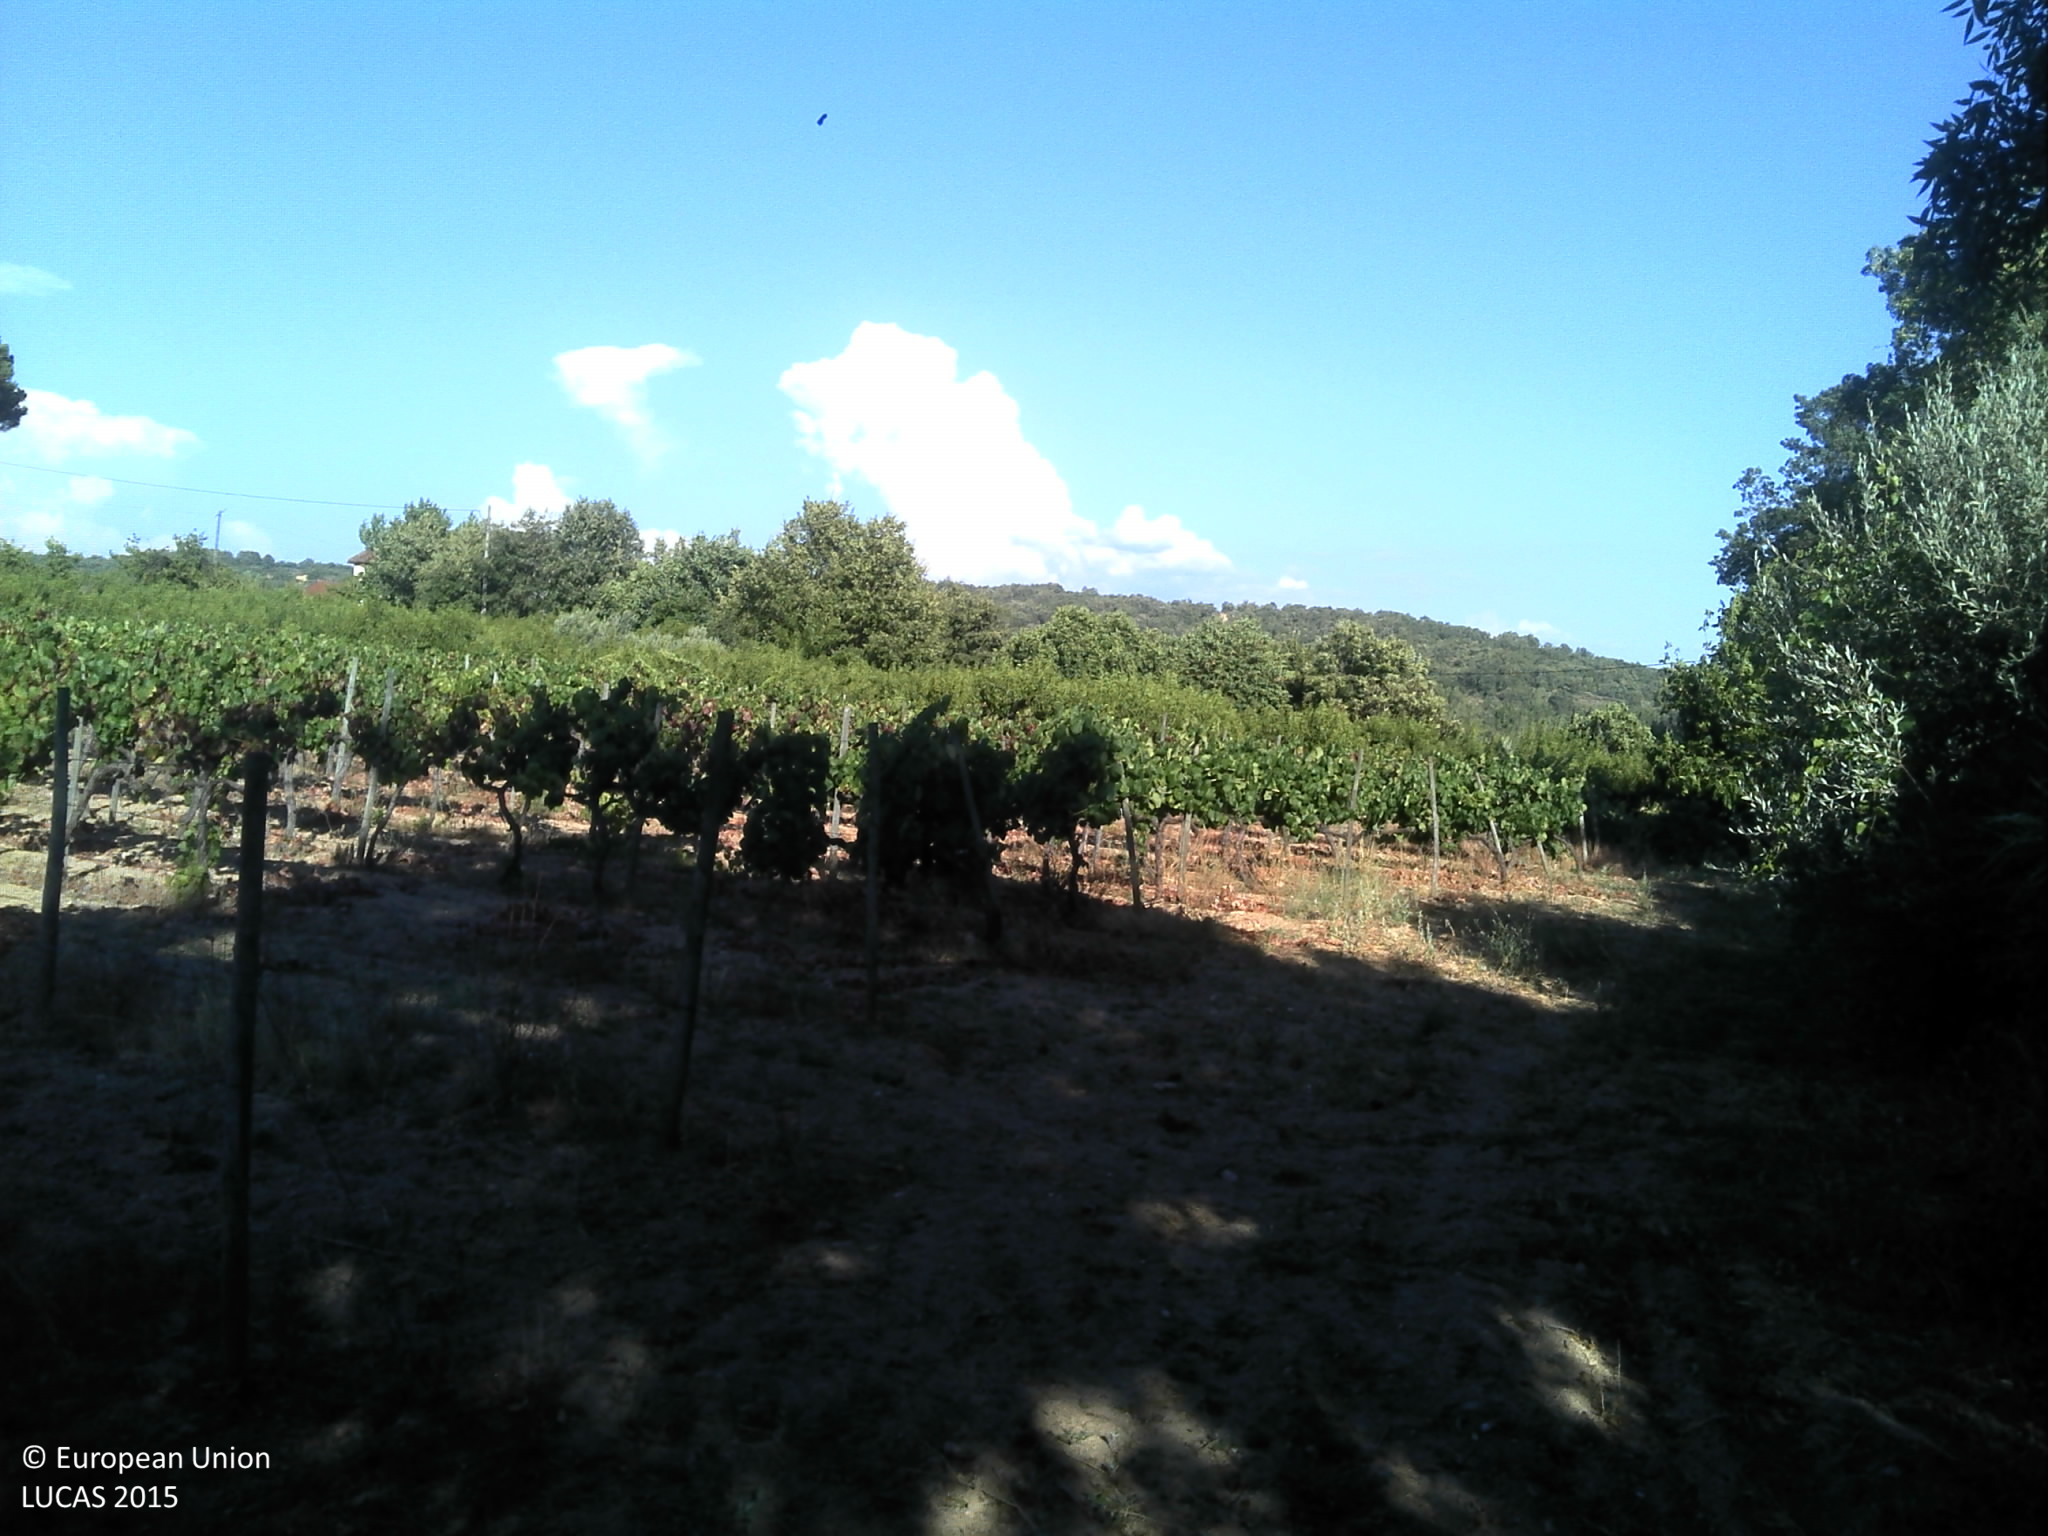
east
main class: Cropland
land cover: Vineyards
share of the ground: 10 - 25 %
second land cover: Other bare soil
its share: > 75 %
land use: Agriculture (excluding fallow land and kitchen gardens)
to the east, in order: Rivers and streams; Shruby margins; Vineyards; Other fruit trees and berries; Tracks; Broadleaved woodland; Artificial constructions in urban areas; Other fruit trees and berries; Artificial constructions in urban areas; Vineyards; Electric lines; Tracks
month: July
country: PT
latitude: 40.3198
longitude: -7.4171
